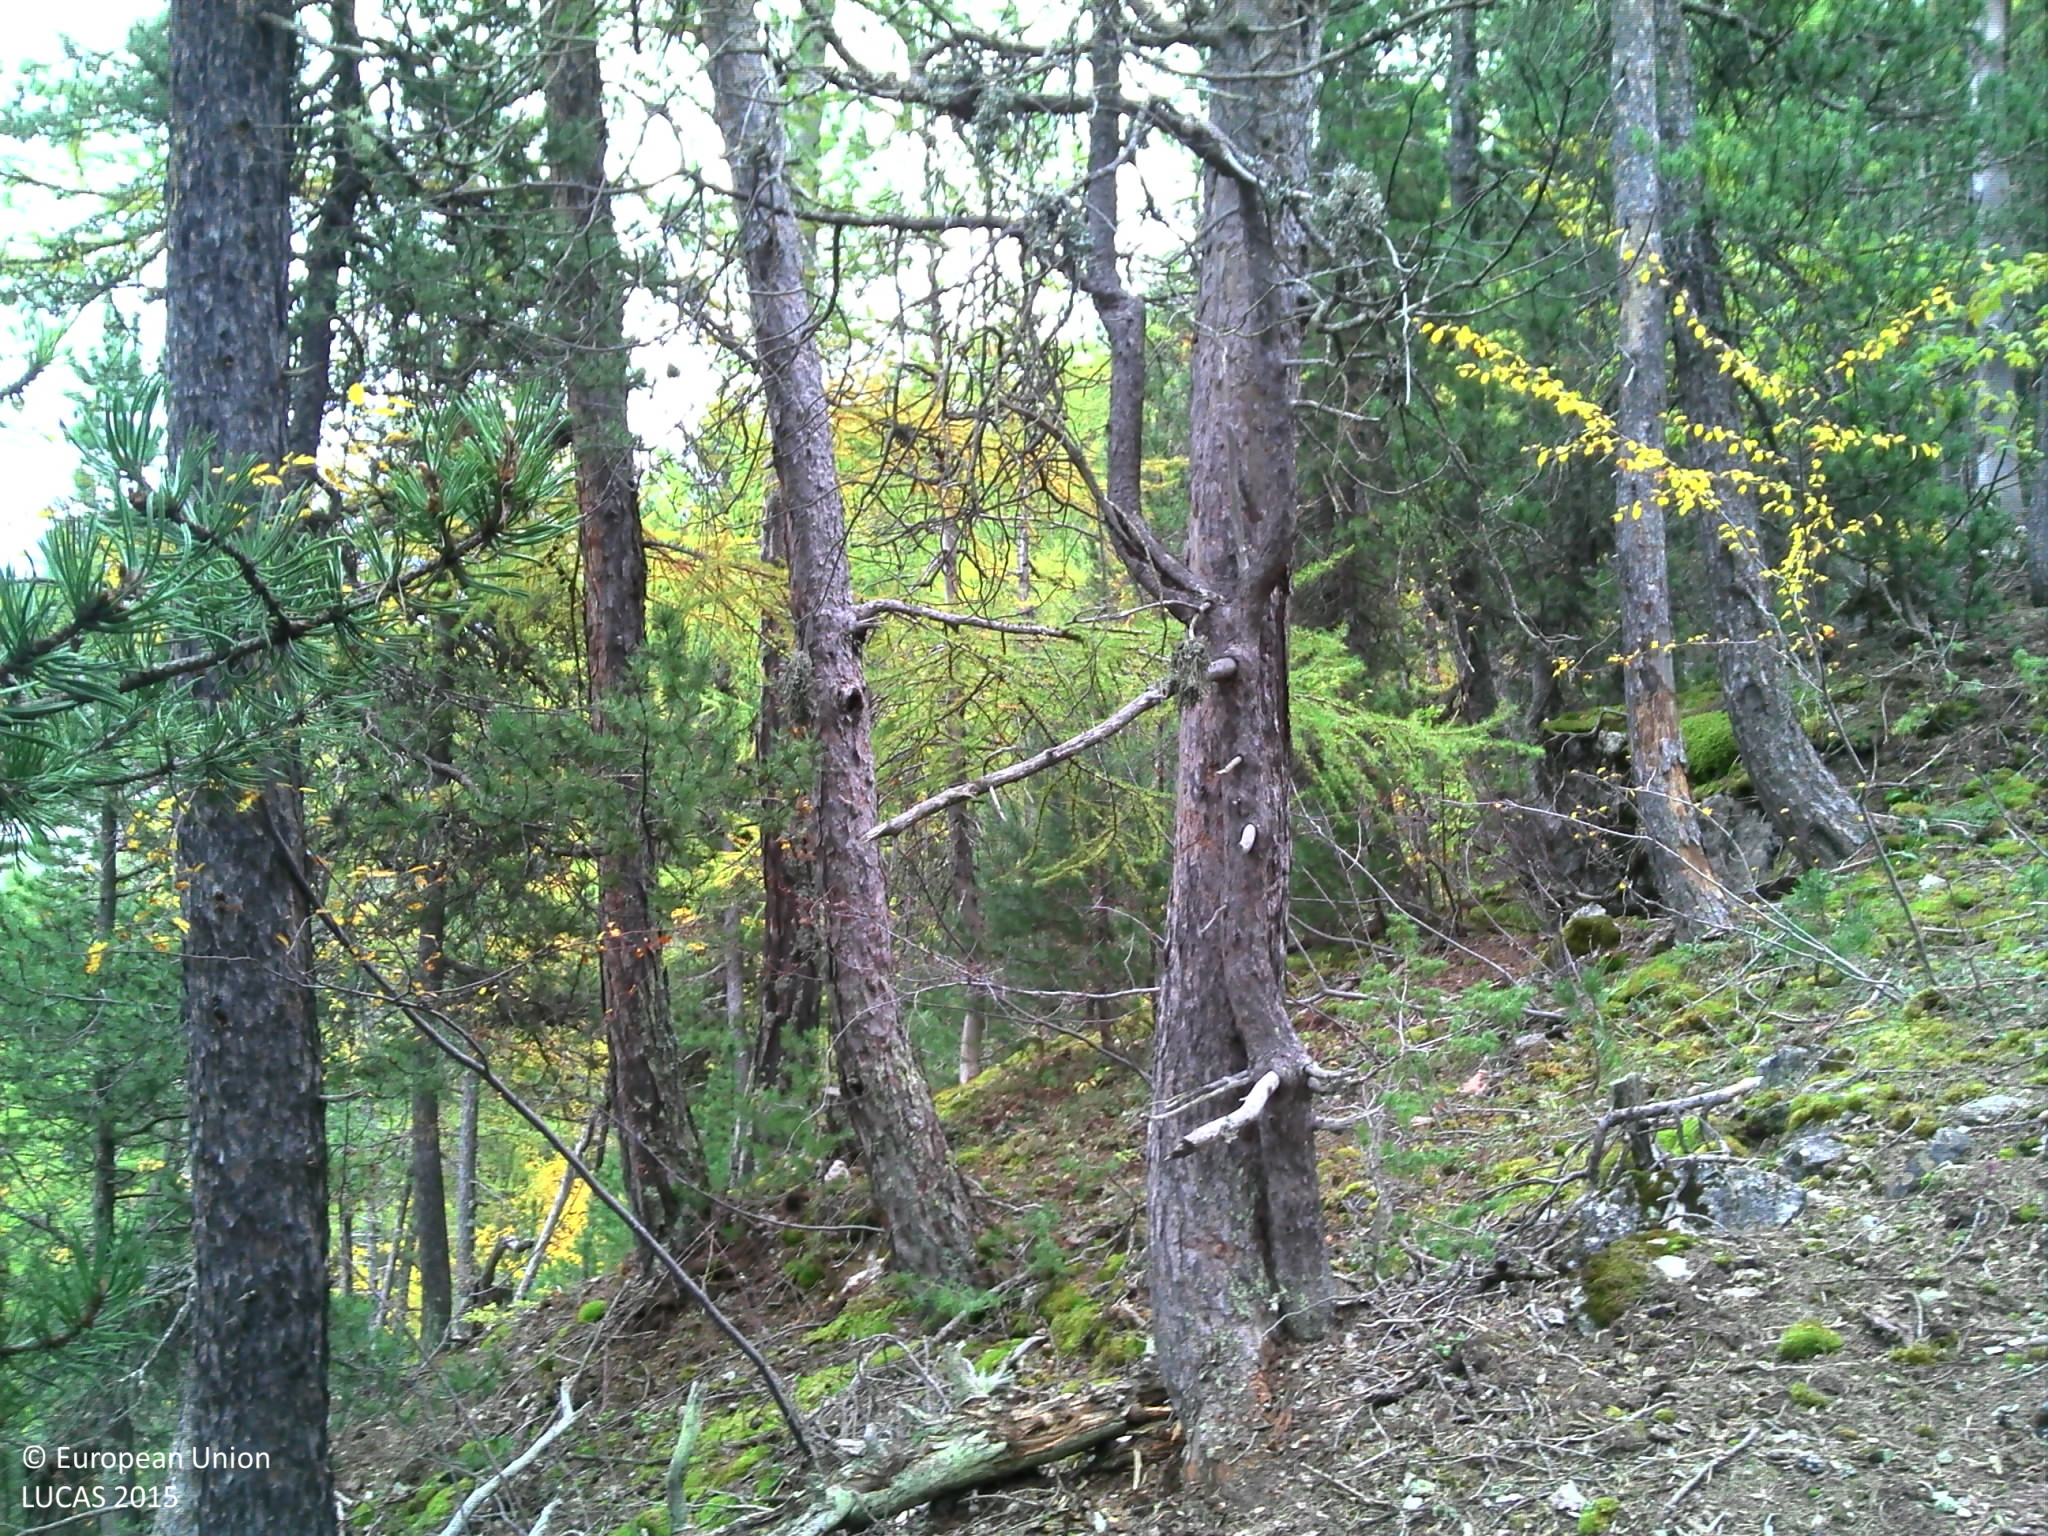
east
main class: Woodland
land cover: Pine dominated coniferous woodland
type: alpine coniferous forest
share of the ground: > 75 %
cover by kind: coniferous forest trees 70 %, unconsolidated bare surface 20 %, shrubs 5 %, lichens and mosses 5 %
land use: Forestry
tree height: > 5 m
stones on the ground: 10 - 25 %
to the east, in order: Pine dominated coniferous woodland; Pine dominated mixed woodland; Pine dominated coniferous woodland; Pine dominated mixed woodland; Other mixed woodland
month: October
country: FR
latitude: 44.8159
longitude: 6.5283
